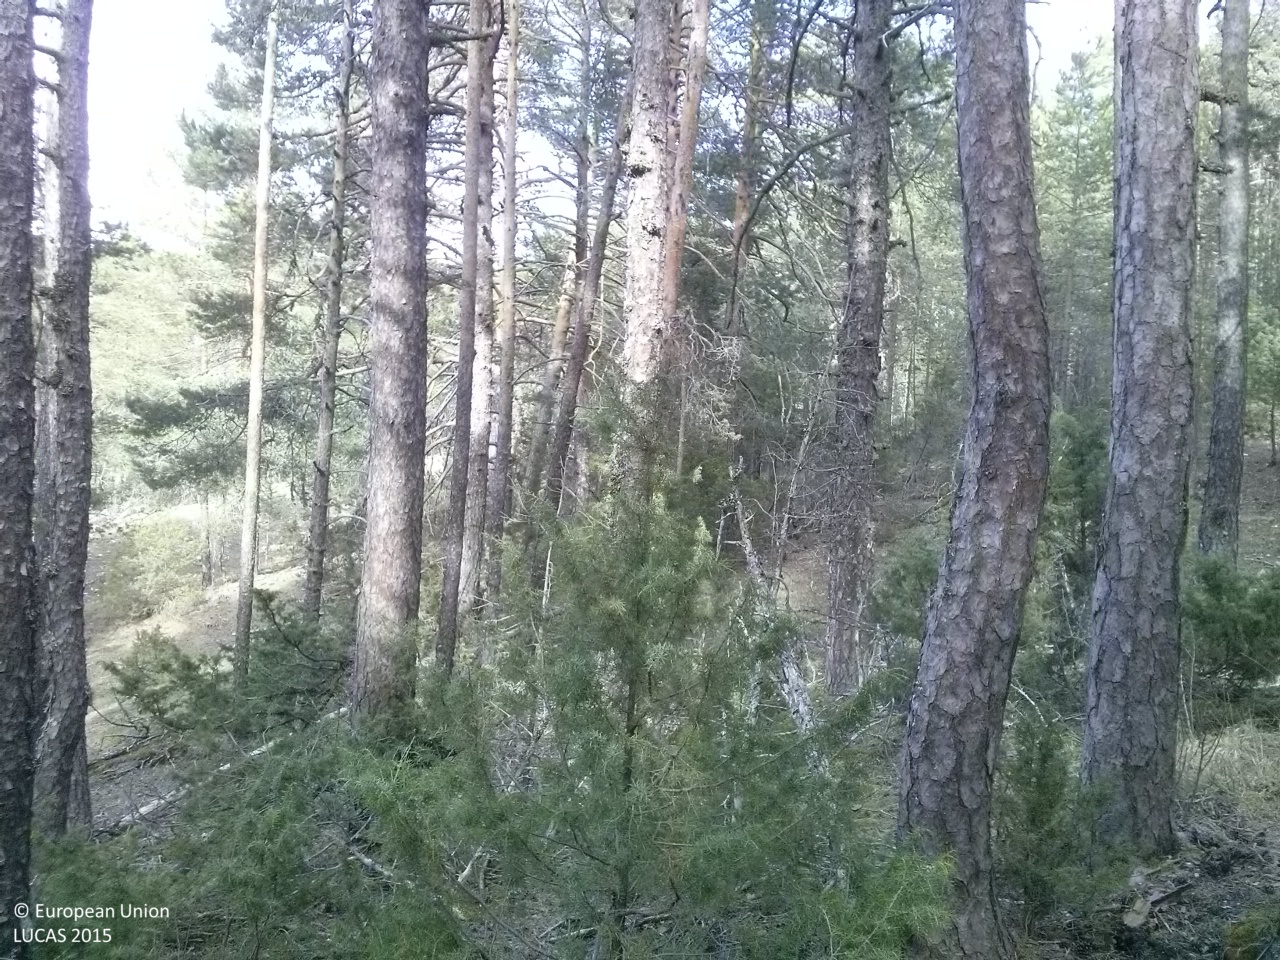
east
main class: Woodland
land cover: Pine dominated coniferous woodland
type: coniferous forest of the mediterranean region
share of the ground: > 75 %
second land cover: Grassland without tree/shrub cover
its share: 10 - 25 %
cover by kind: coniferous forest trees 90 %, herbaceous plants 10 %
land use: Forestry
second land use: Agriculture (excluding fallow land and kitchen gardens)
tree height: > 5 m
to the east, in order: Pine dominated coniferous woodland; Grassland without tree/shrub cover; Pine dominated coniferous woodland
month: April
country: ES
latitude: 40.2938
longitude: -1.8621
